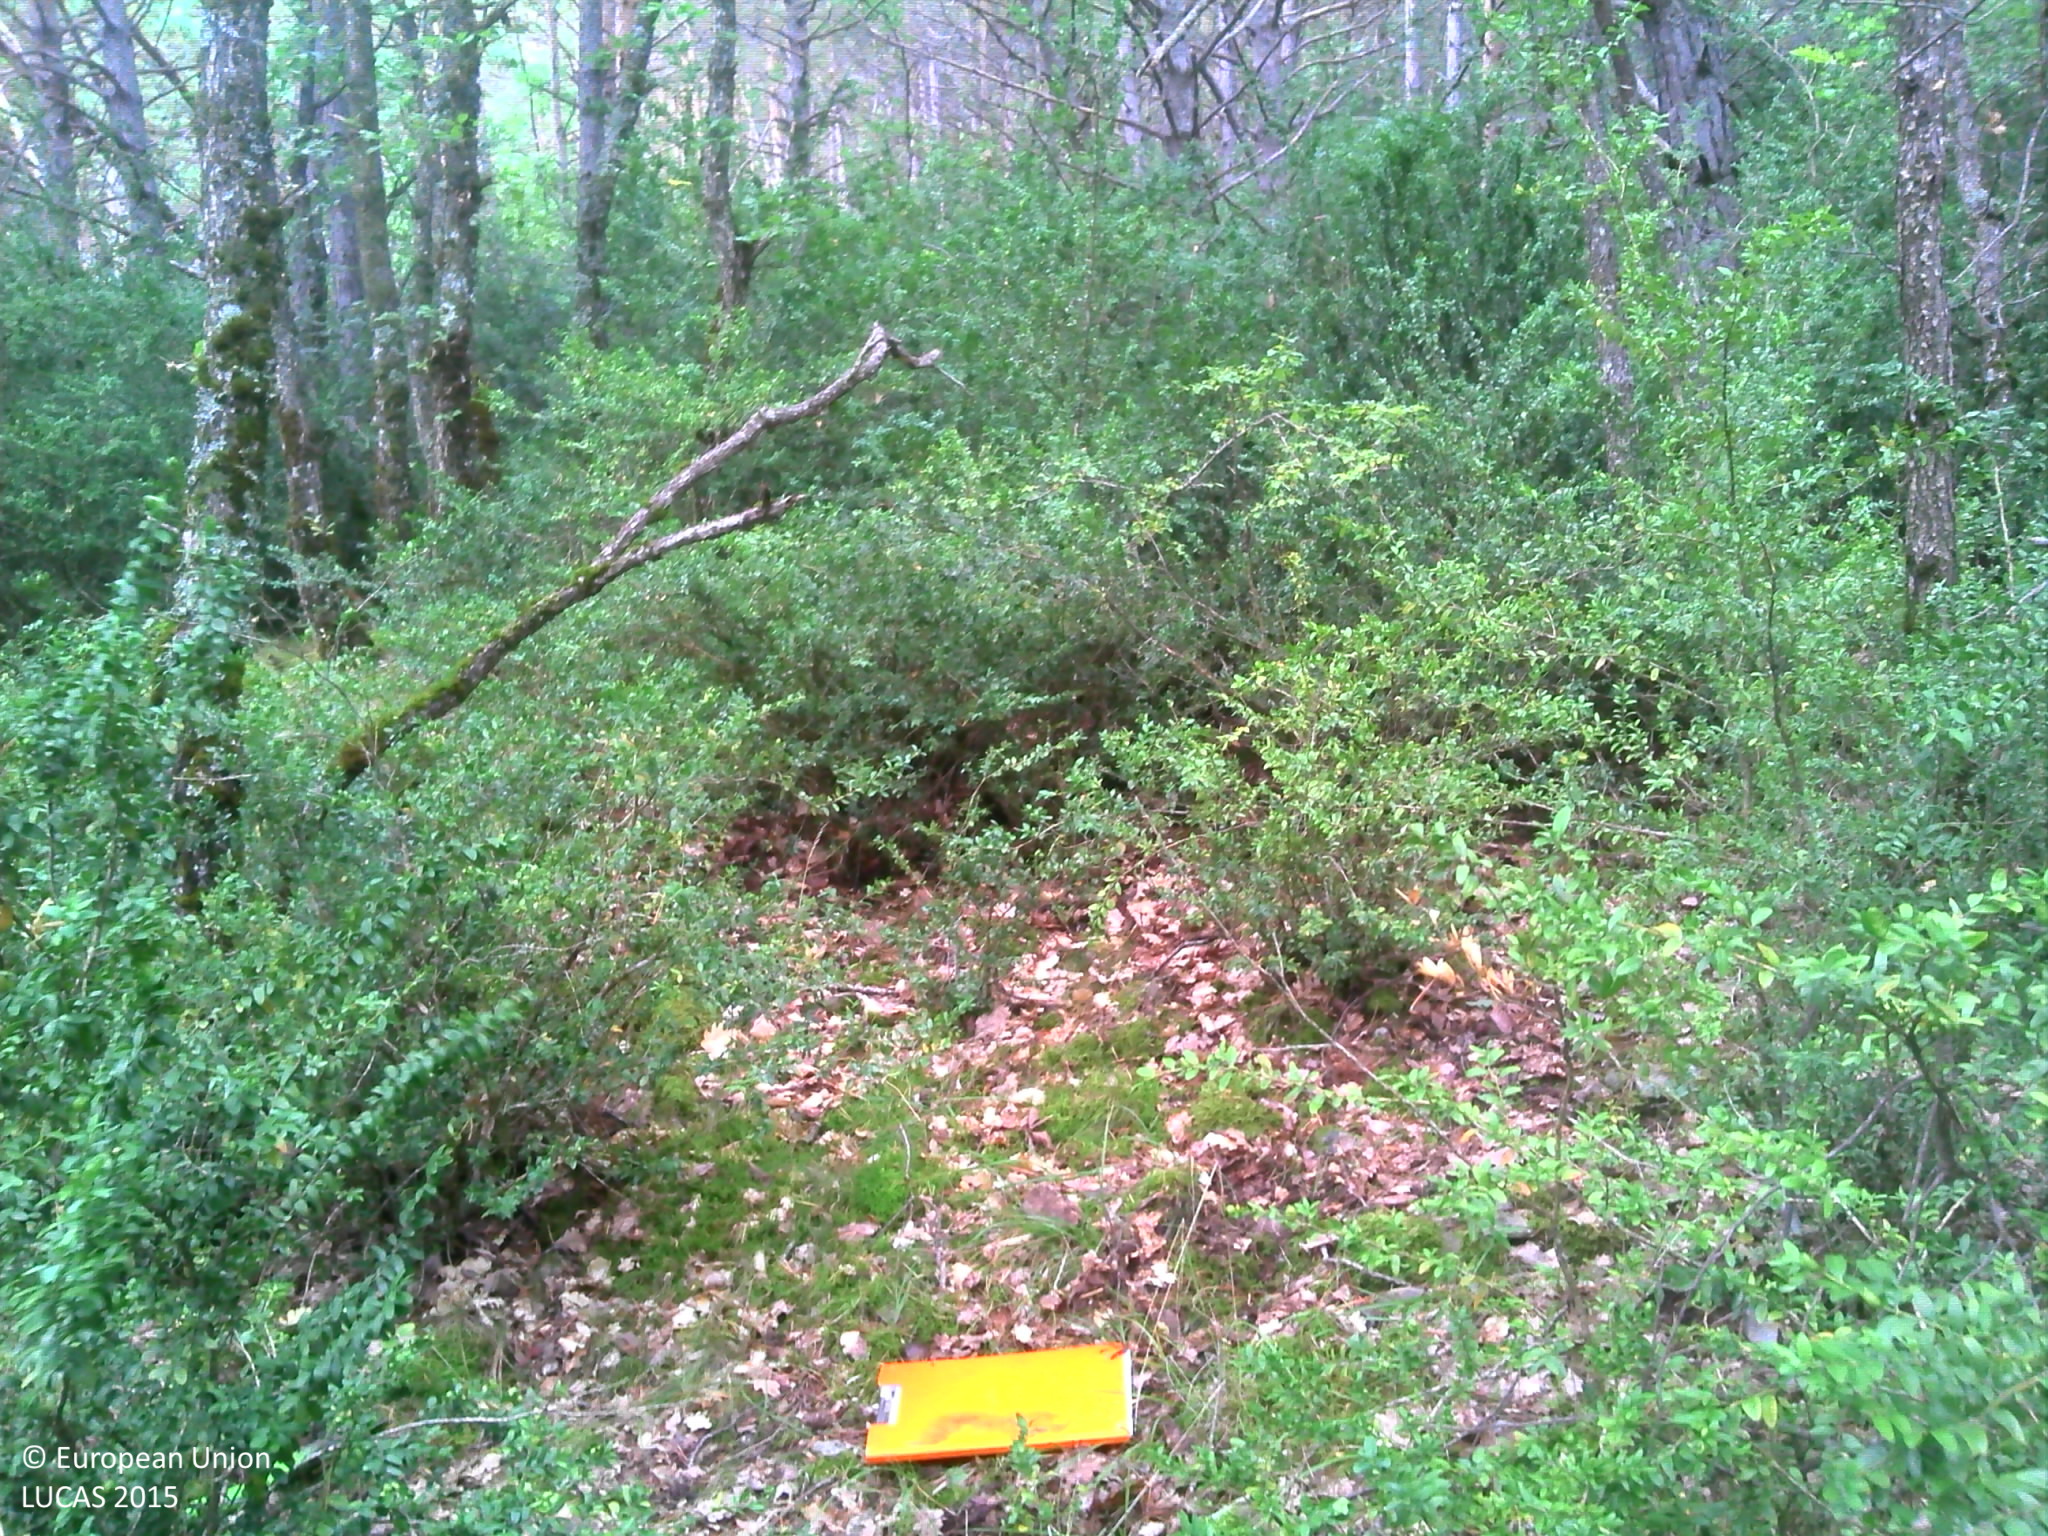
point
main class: Woodland
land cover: Pine dominated mixed woodland
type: alpine coniferous forest
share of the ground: > 75 %
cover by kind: broadleaved forest trees 50 %, coniferous forest trees 20 %, shrubs 20 %, herbaceous plants 10 %
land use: Forestry
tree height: > 5 m
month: September
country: FR
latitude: 44.5987
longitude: 5.5596
